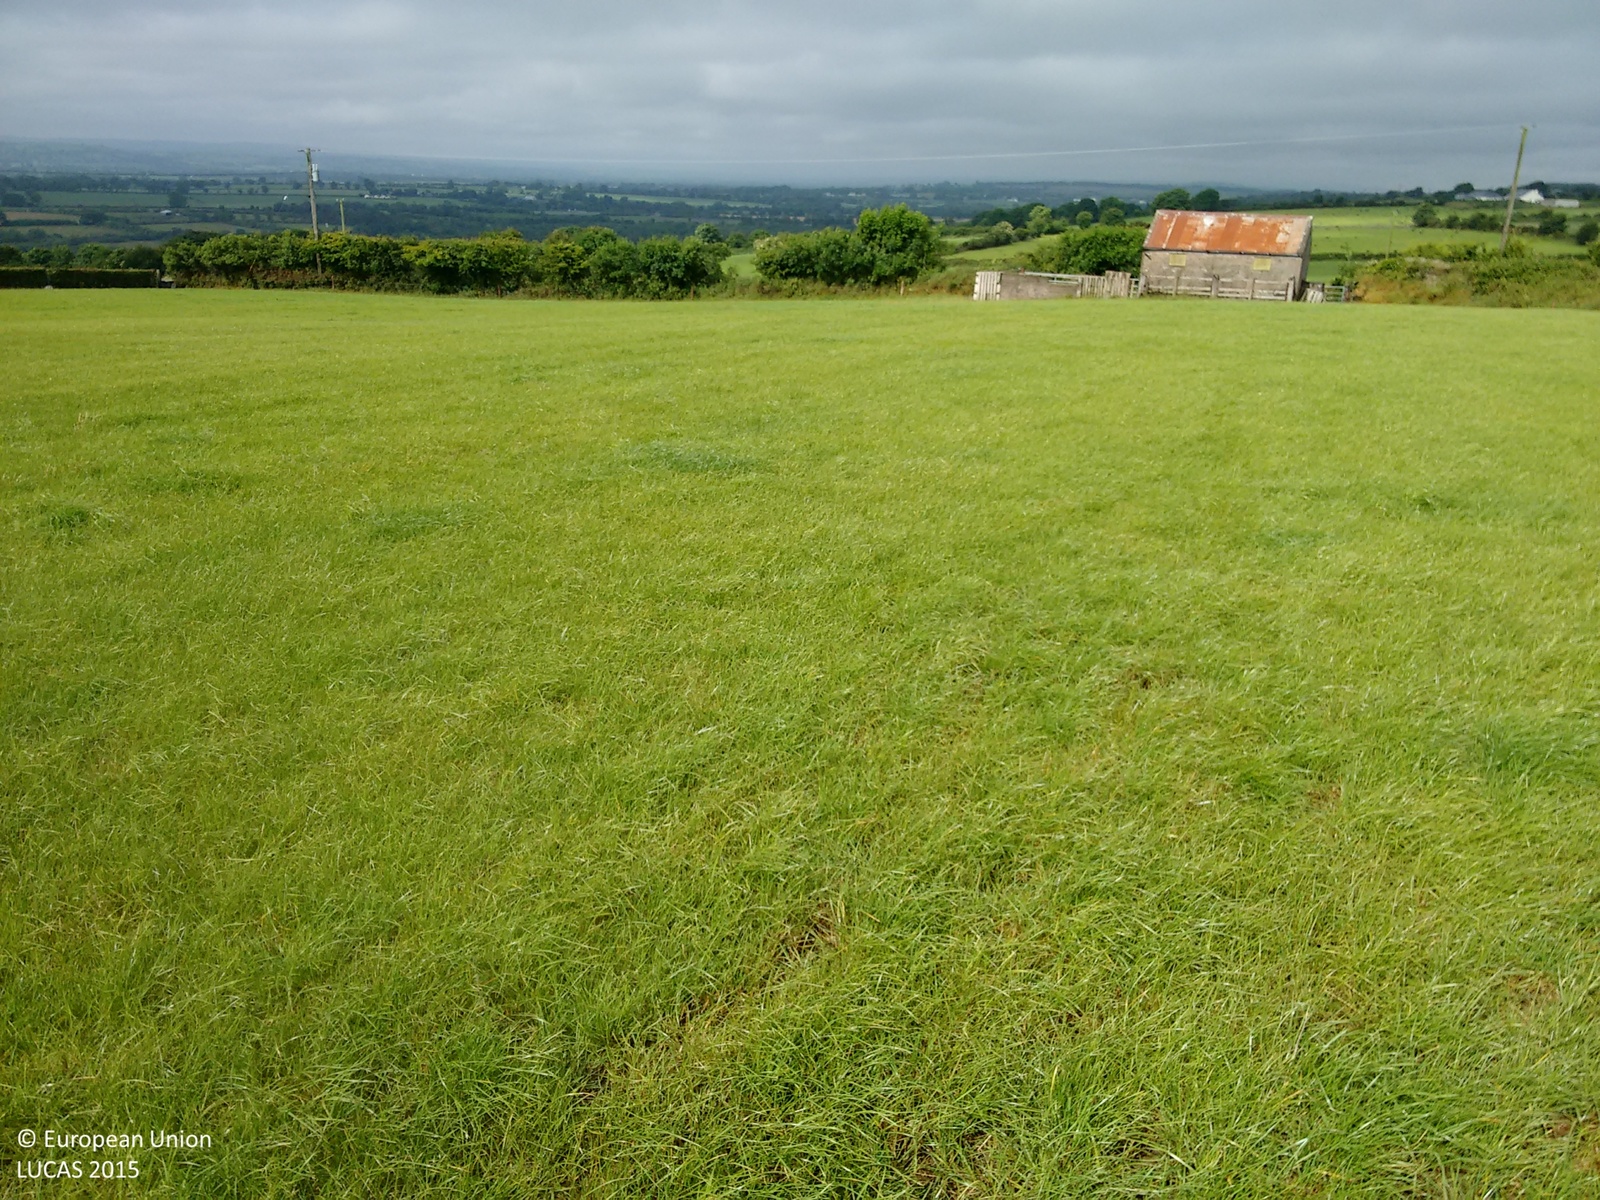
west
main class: Grassland
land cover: Grassland without tree/shrub cover
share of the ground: > 75 %
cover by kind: herbaceous plants 100 %
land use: Agriculture (excluding fallow land and kitchen gardens)
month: June
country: IE
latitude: 52.1262
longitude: -8.1328
